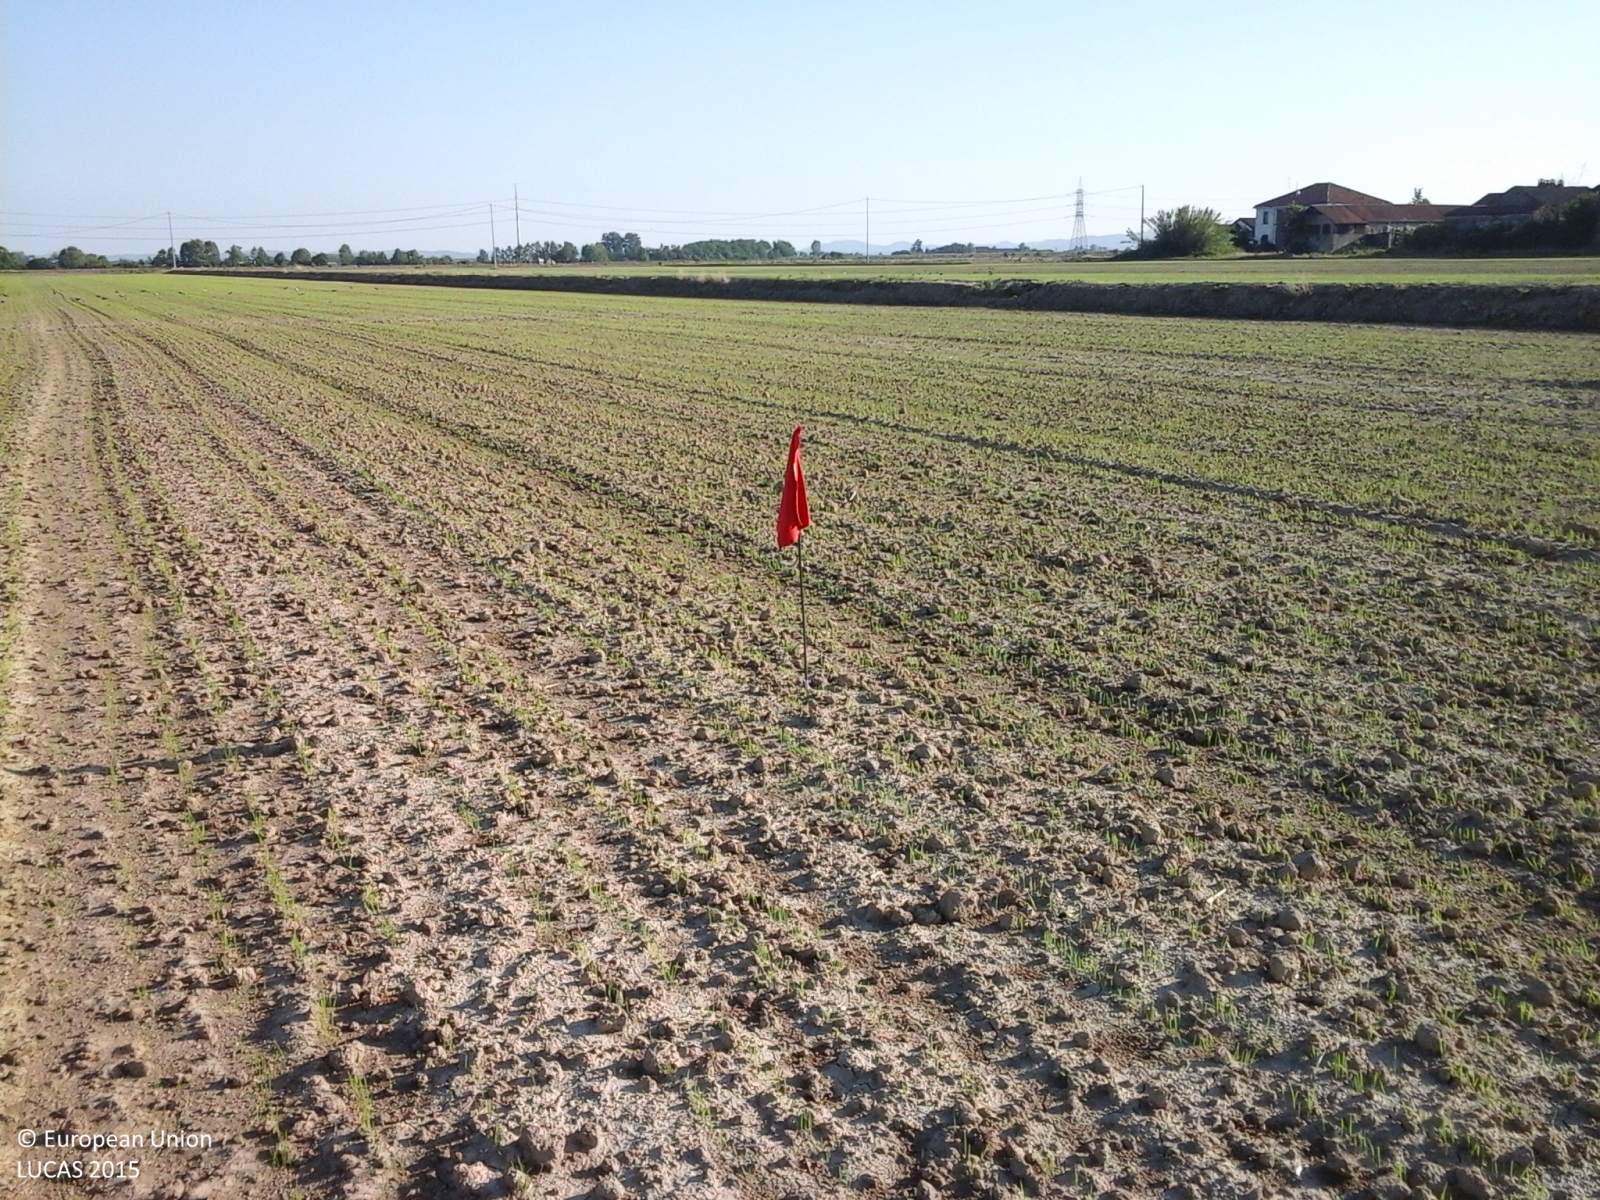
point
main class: Cropland
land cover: Rice
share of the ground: < 10 %
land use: Agriculture (excluding fallow land and kitchen gardens)
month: May
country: IT
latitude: 45.2941
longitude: 8.4089
